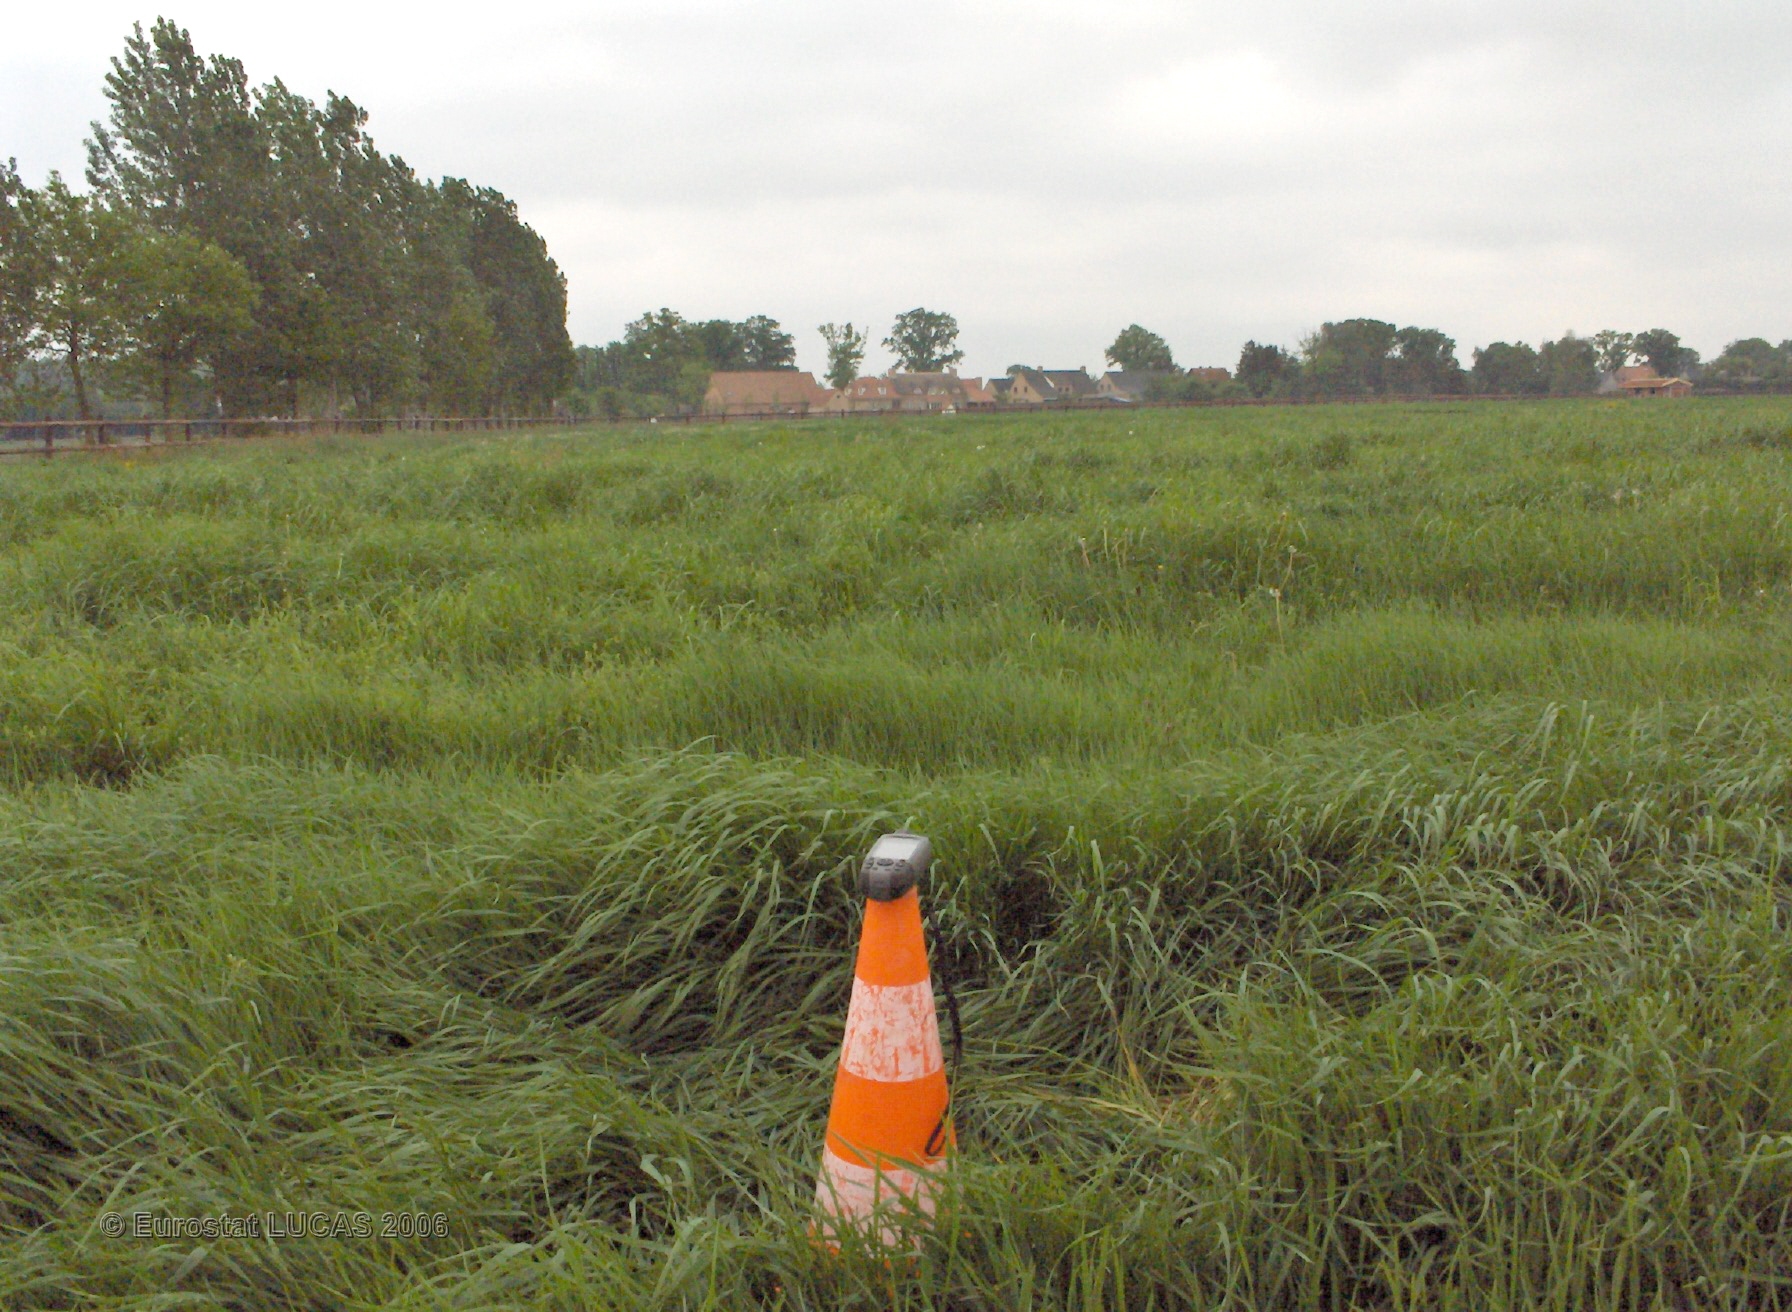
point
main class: Grassland
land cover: Grassland without tree/shrub cover
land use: Agriculture (excluding fallow land and kitchen gardens)
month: May
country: BE
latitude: 51.4537
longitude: 4.4263
